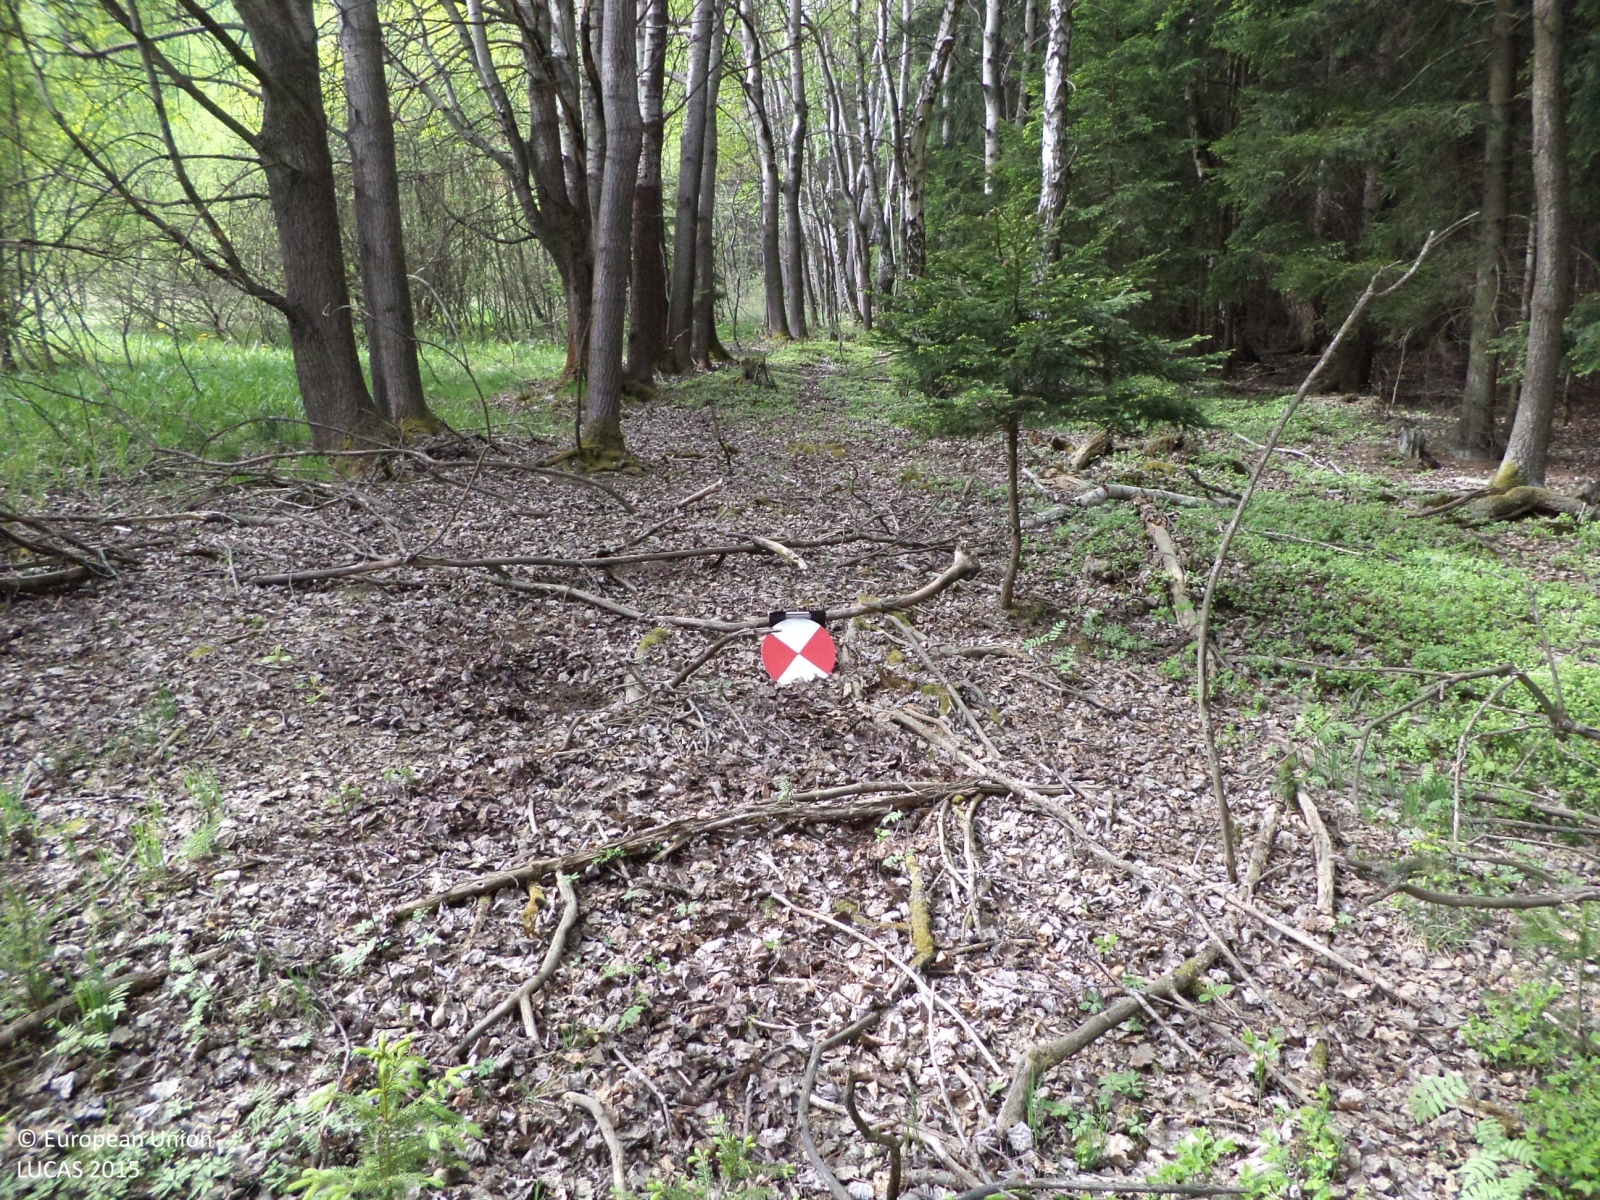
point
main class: Woodland
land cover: Spruce dominated coniferous woodland
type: hemiboreal forest and nemoral coniferous forest and mixed broadleaved-coniferous forest
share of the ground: > 75 %
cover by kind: coniferous forest trees 70 %, broadleaved forest trees 20 %, herbaceous plants 10 %
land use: Forestry
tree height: > 5 m
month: May
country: CZ
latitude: 49.3835
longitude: 15.1409
